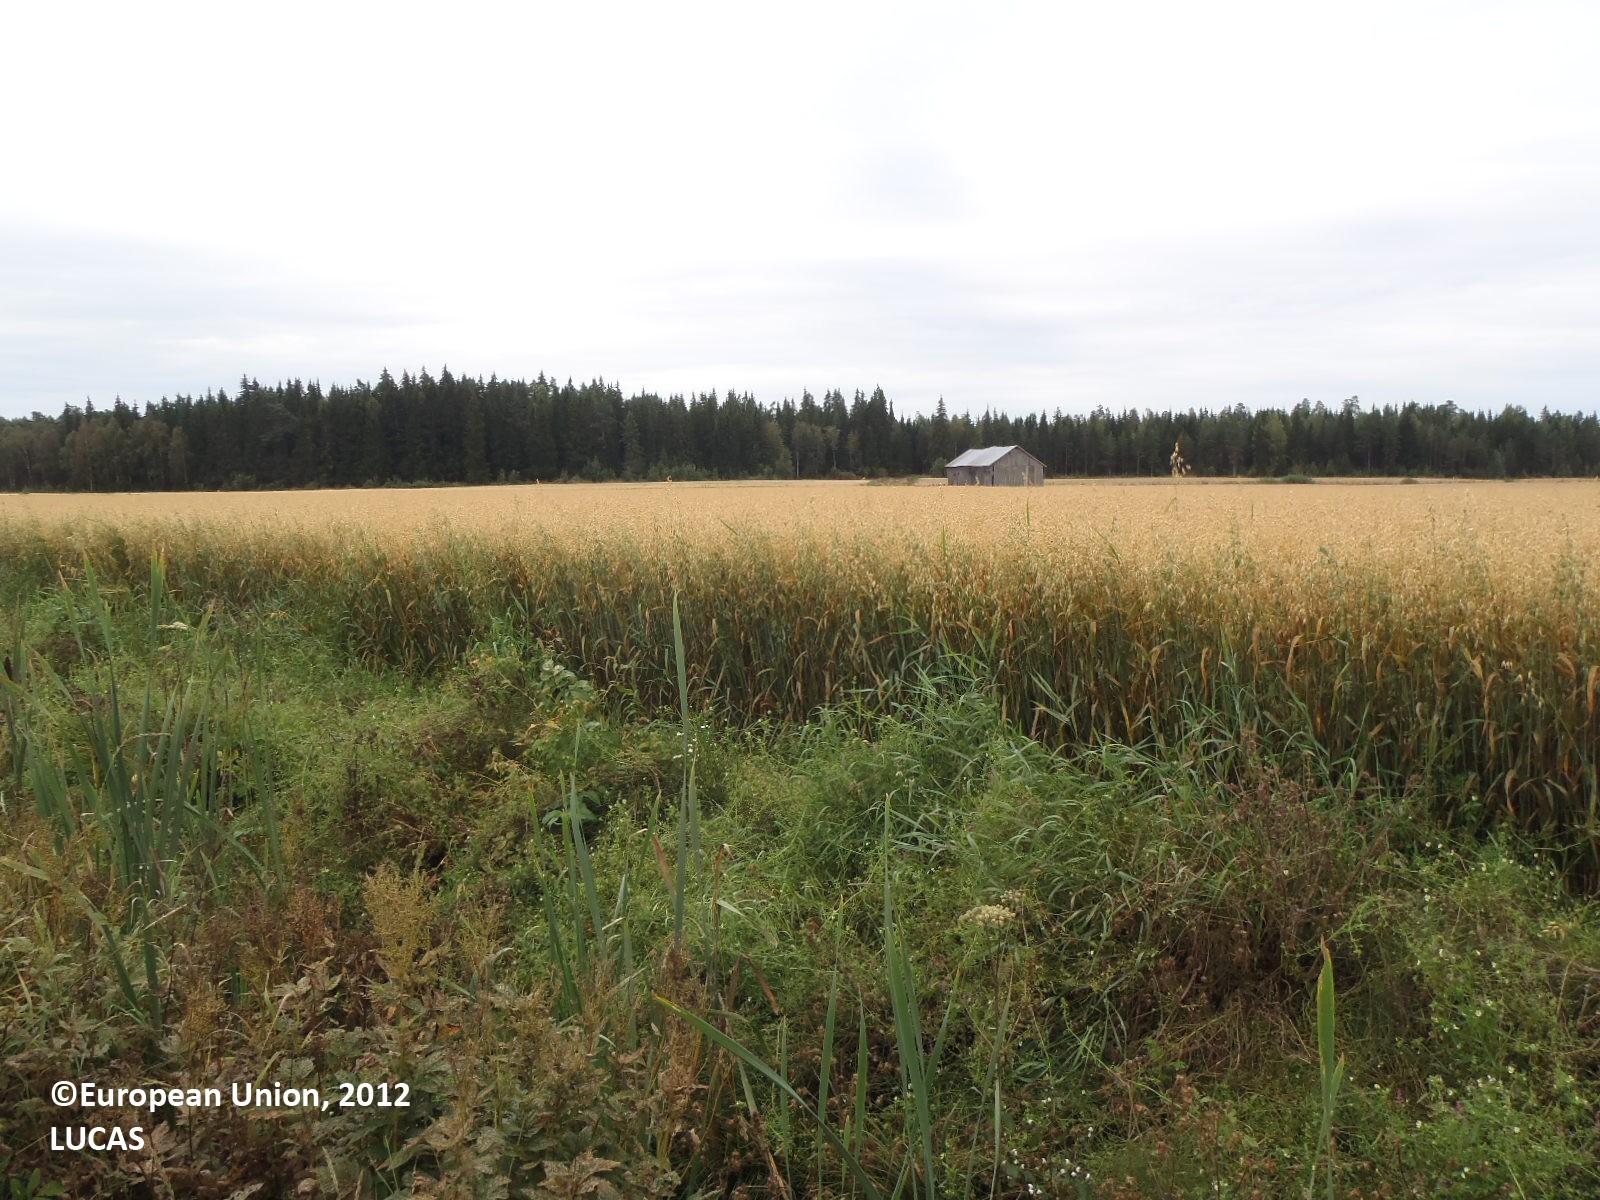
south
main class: Cropland
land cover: Common wheat
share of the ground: > 75 %
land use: Agriculture (excluding fallow land and kitchen gardens)
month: August
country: FI
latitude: 60.8697
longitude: 21.7887
